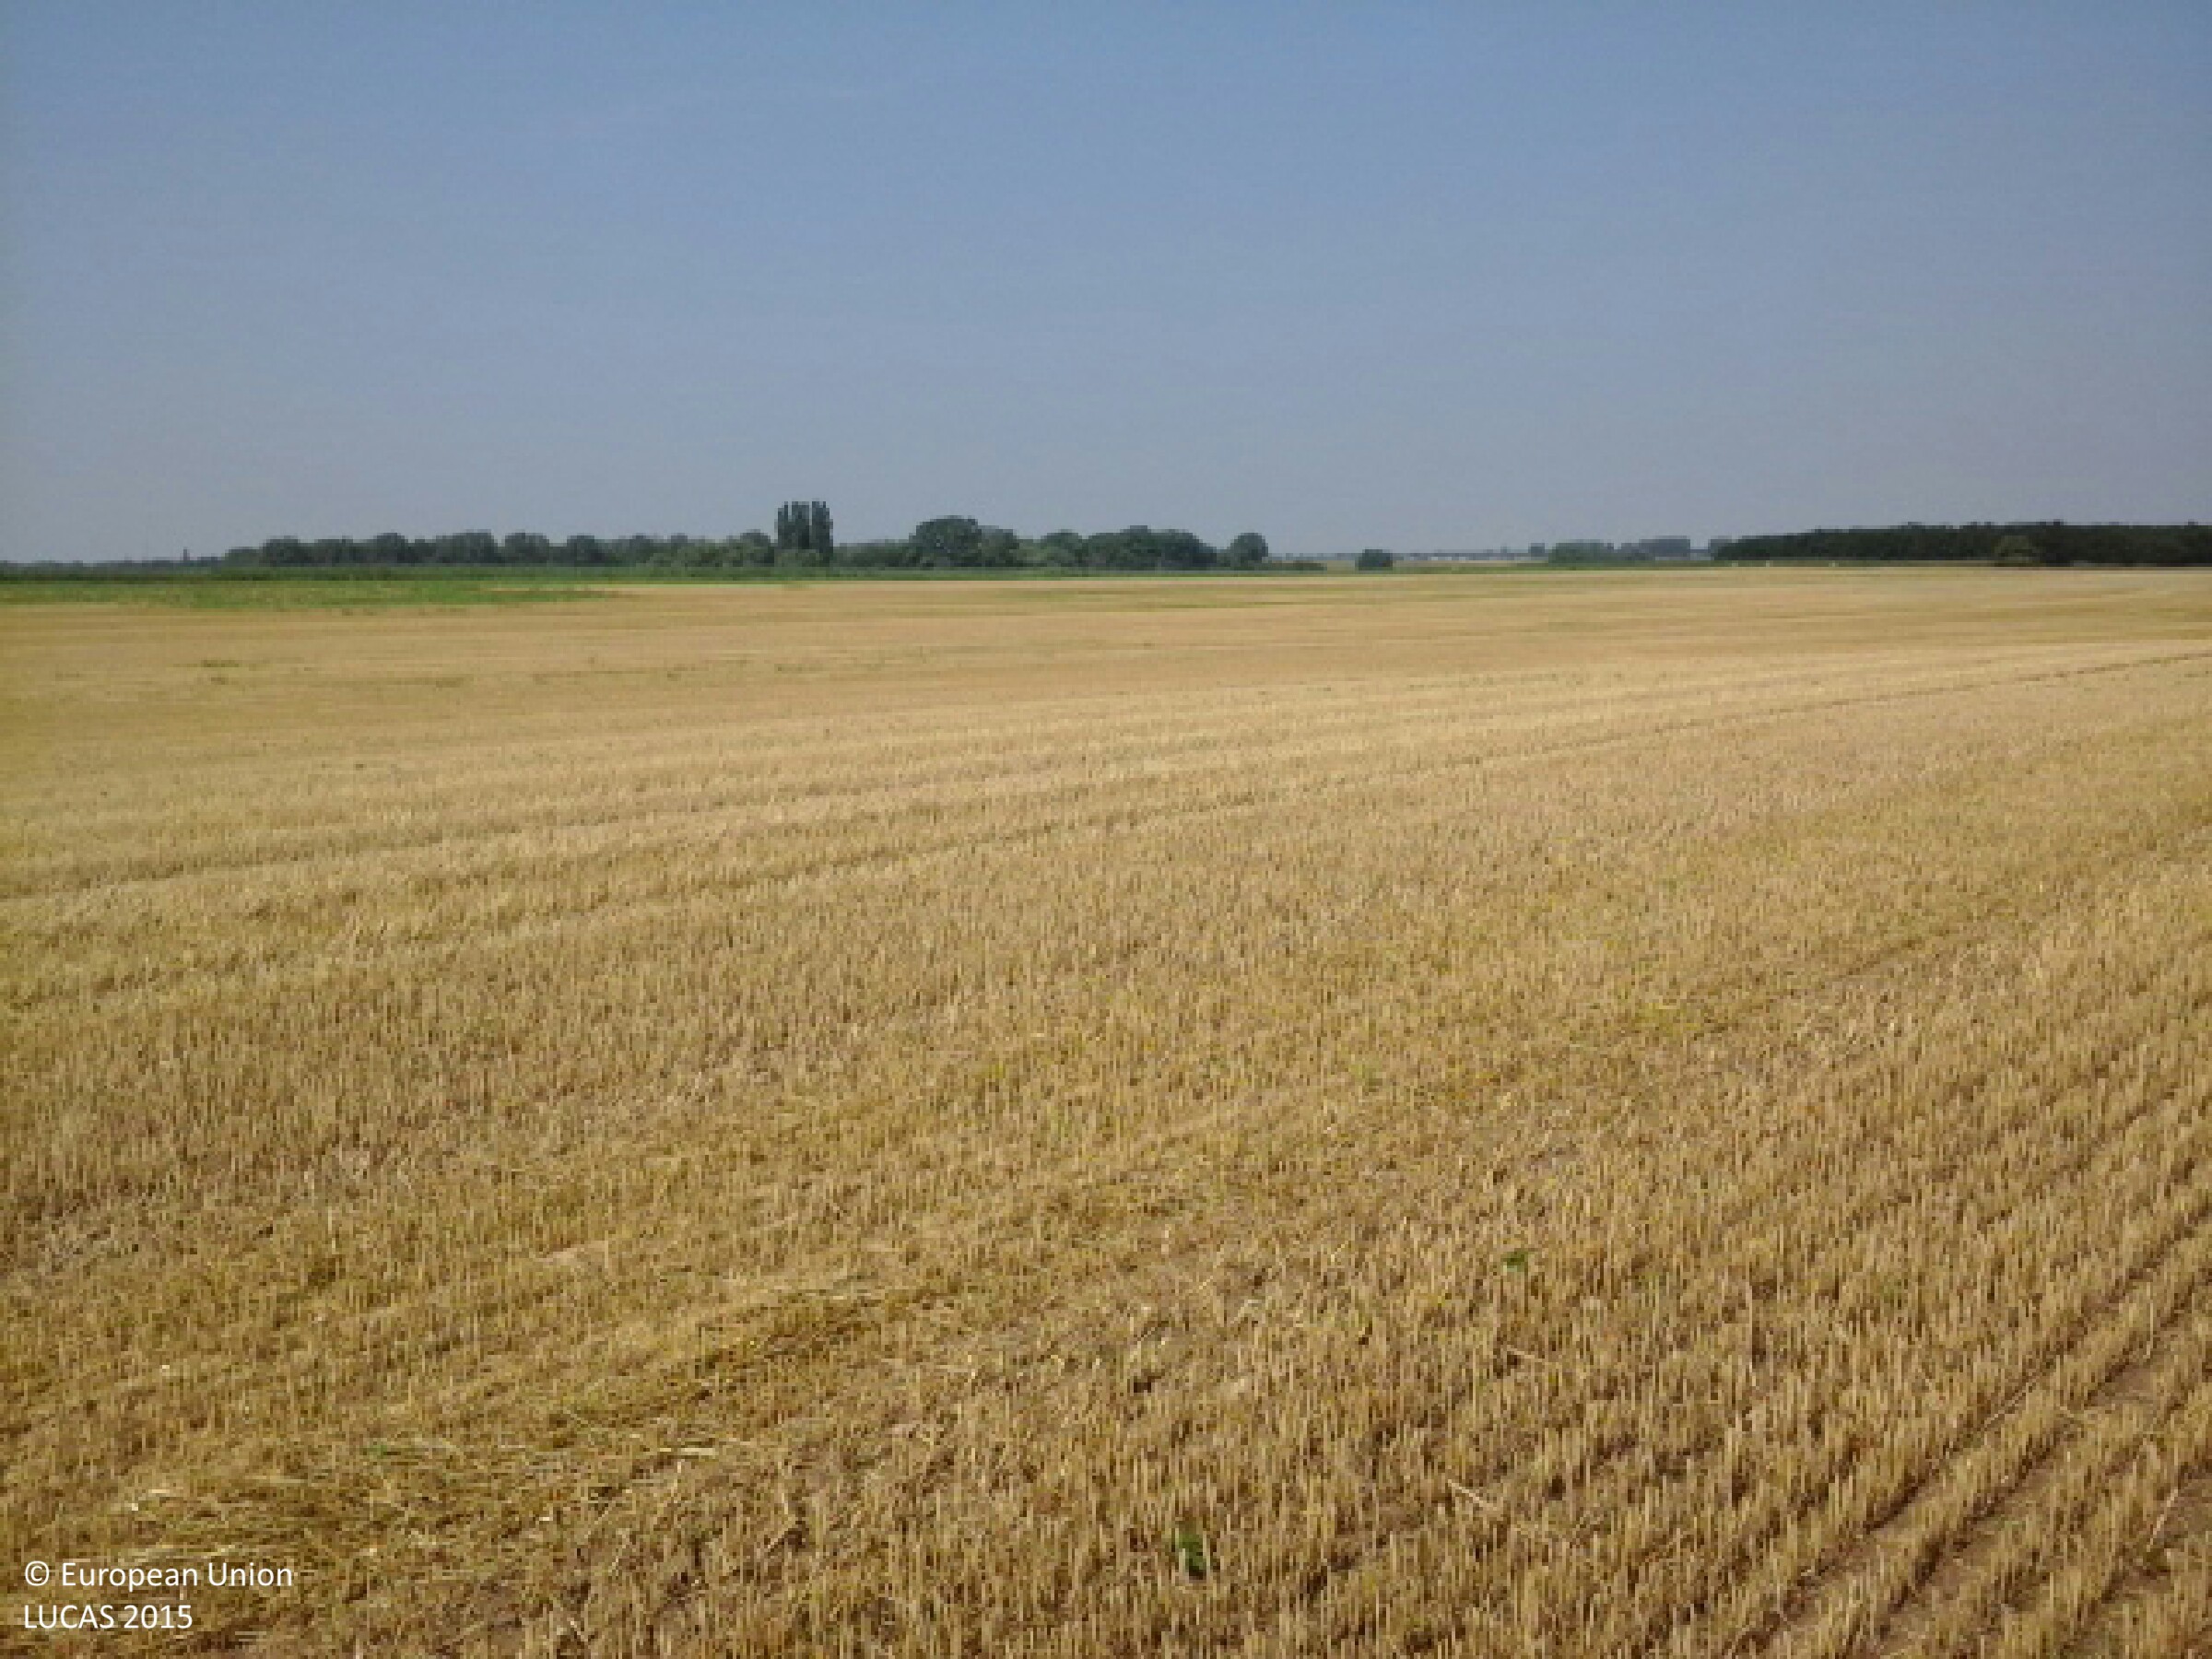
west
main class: Cropland
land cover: Triticale
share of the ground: 10 - 25 %
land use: Agriculture (excluding fallow land and kitchen gardens)
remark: Harvested field
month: August
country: HU
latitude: 47.5451
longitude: 18.1030
